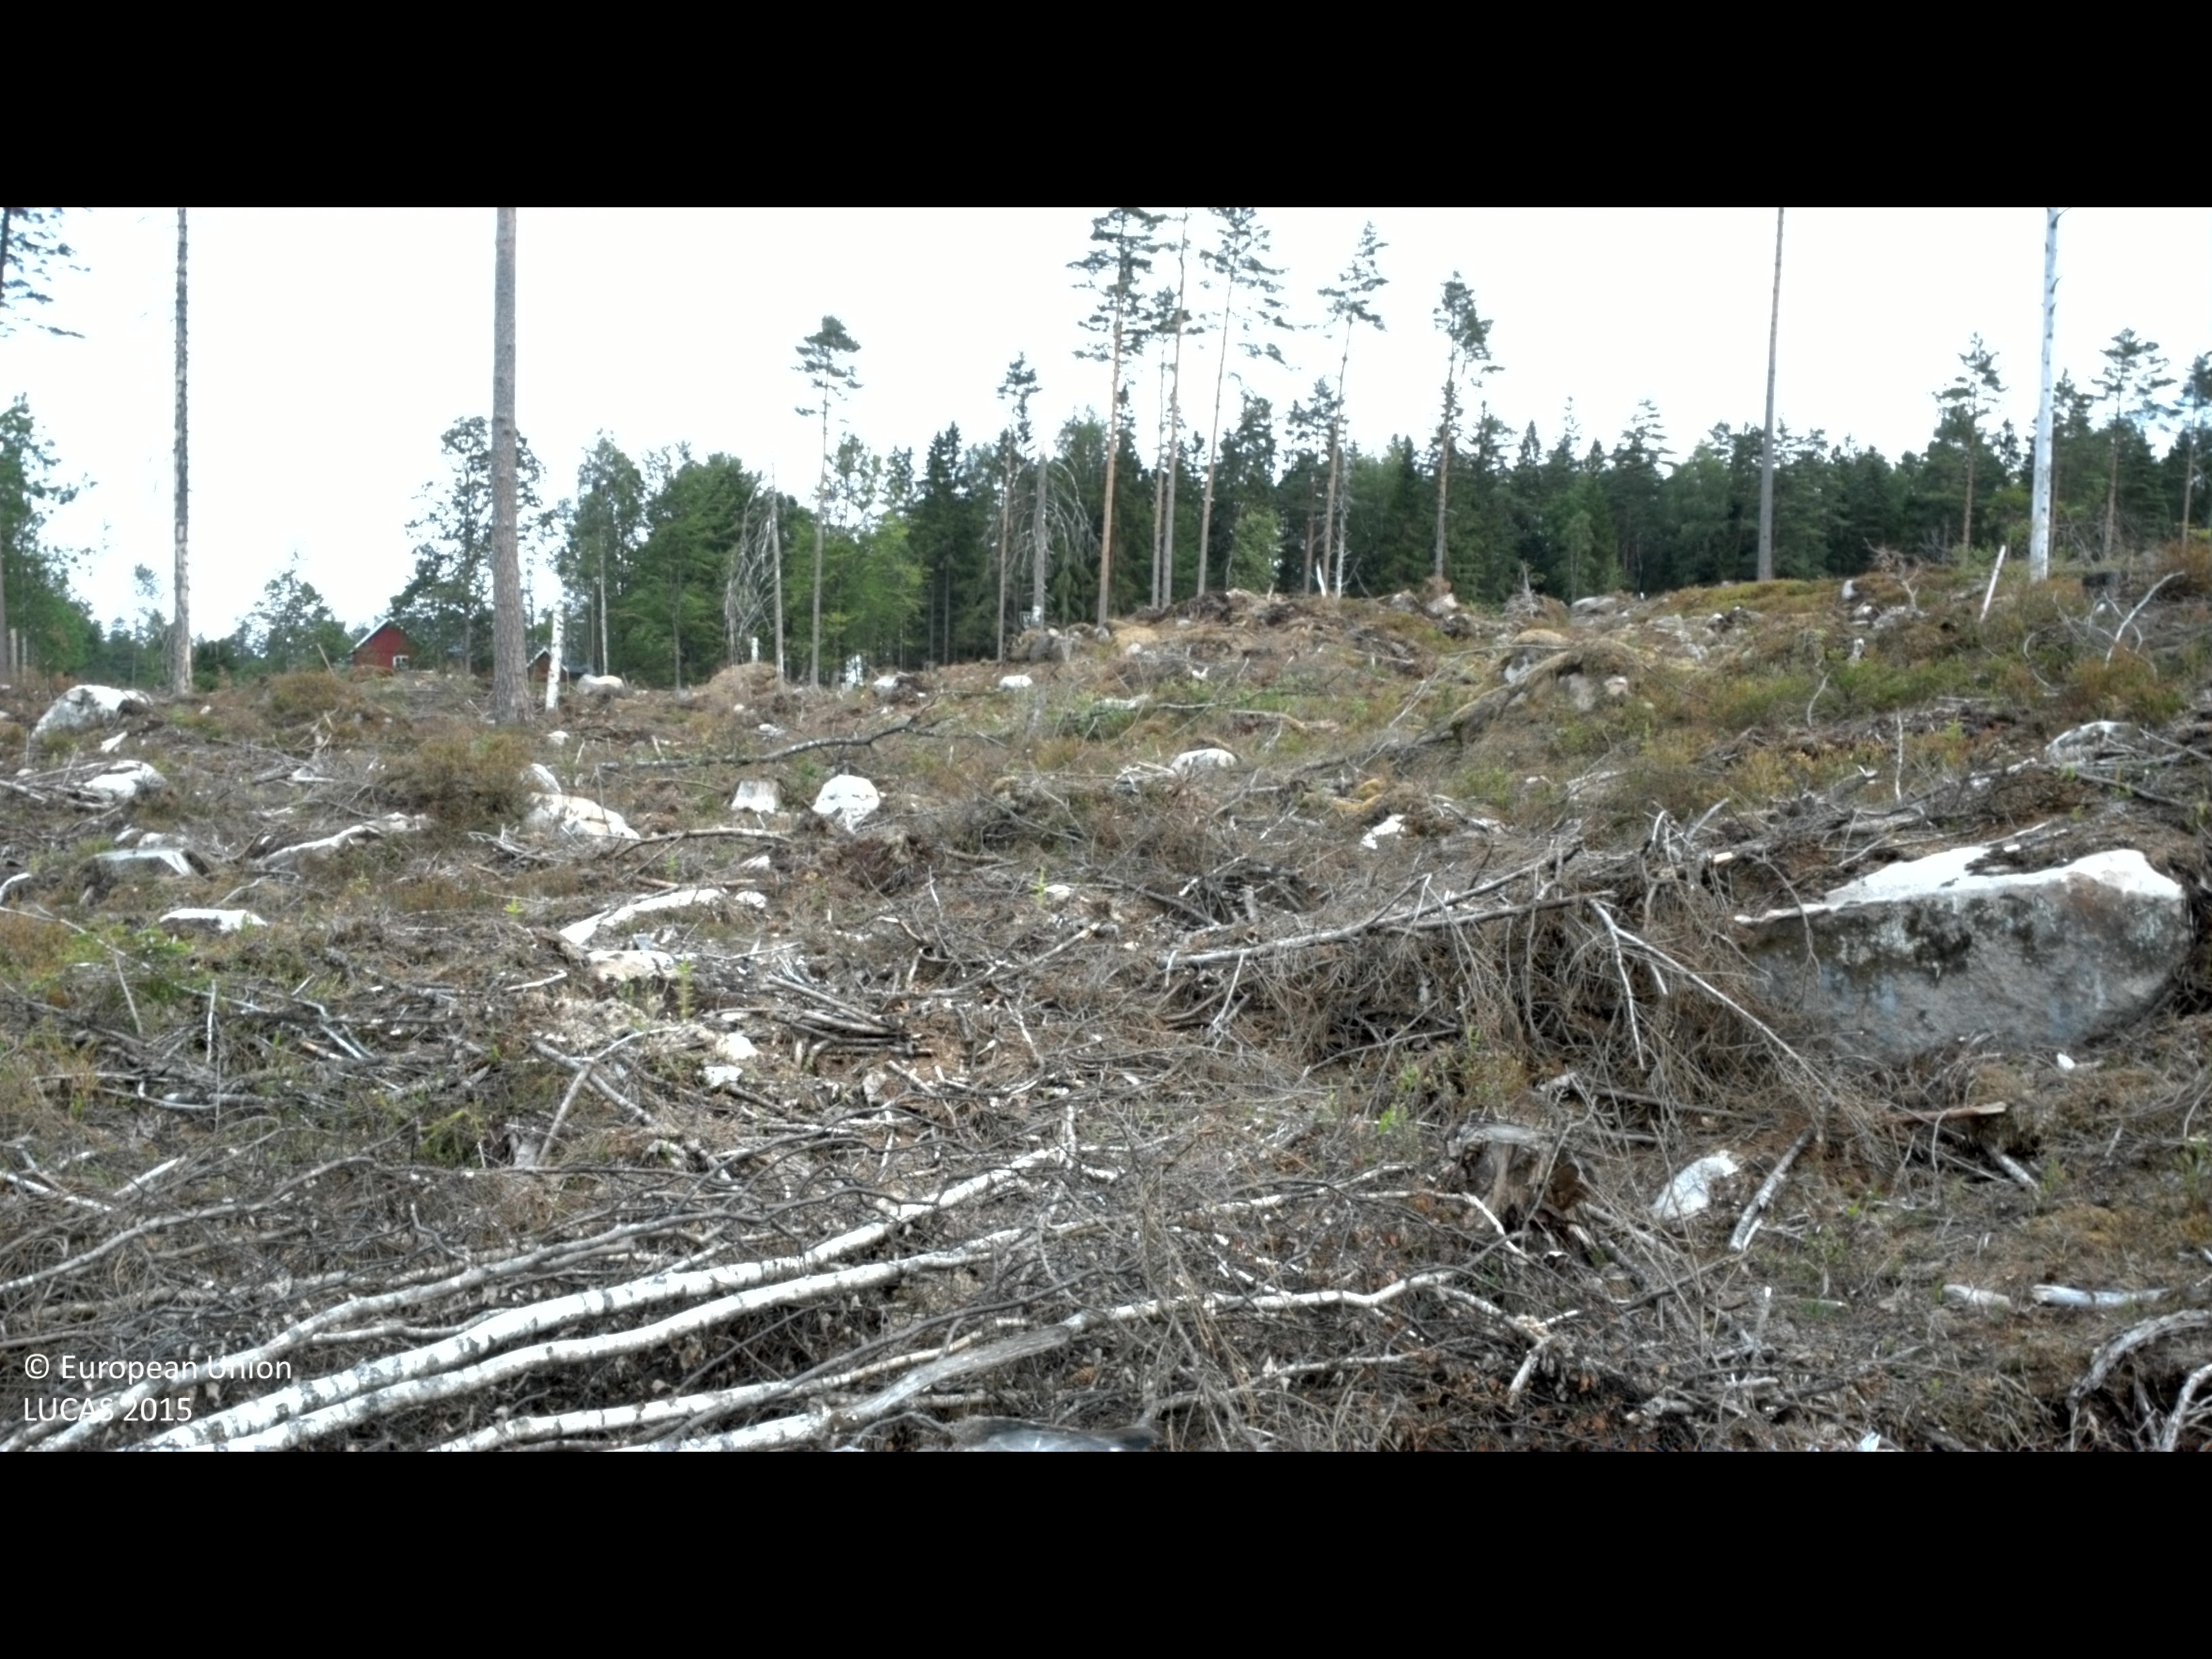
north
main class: Shrubland
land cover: Shrubland without tree cover
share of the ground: 10 - 25 %
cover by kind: unconsolidated bare surface 70 %, shrubs 20 %, consolidated bare surface 10 %
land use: Forestry
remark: Clear cut
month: July
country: SE
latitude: 56.4704
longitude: 14.4615
